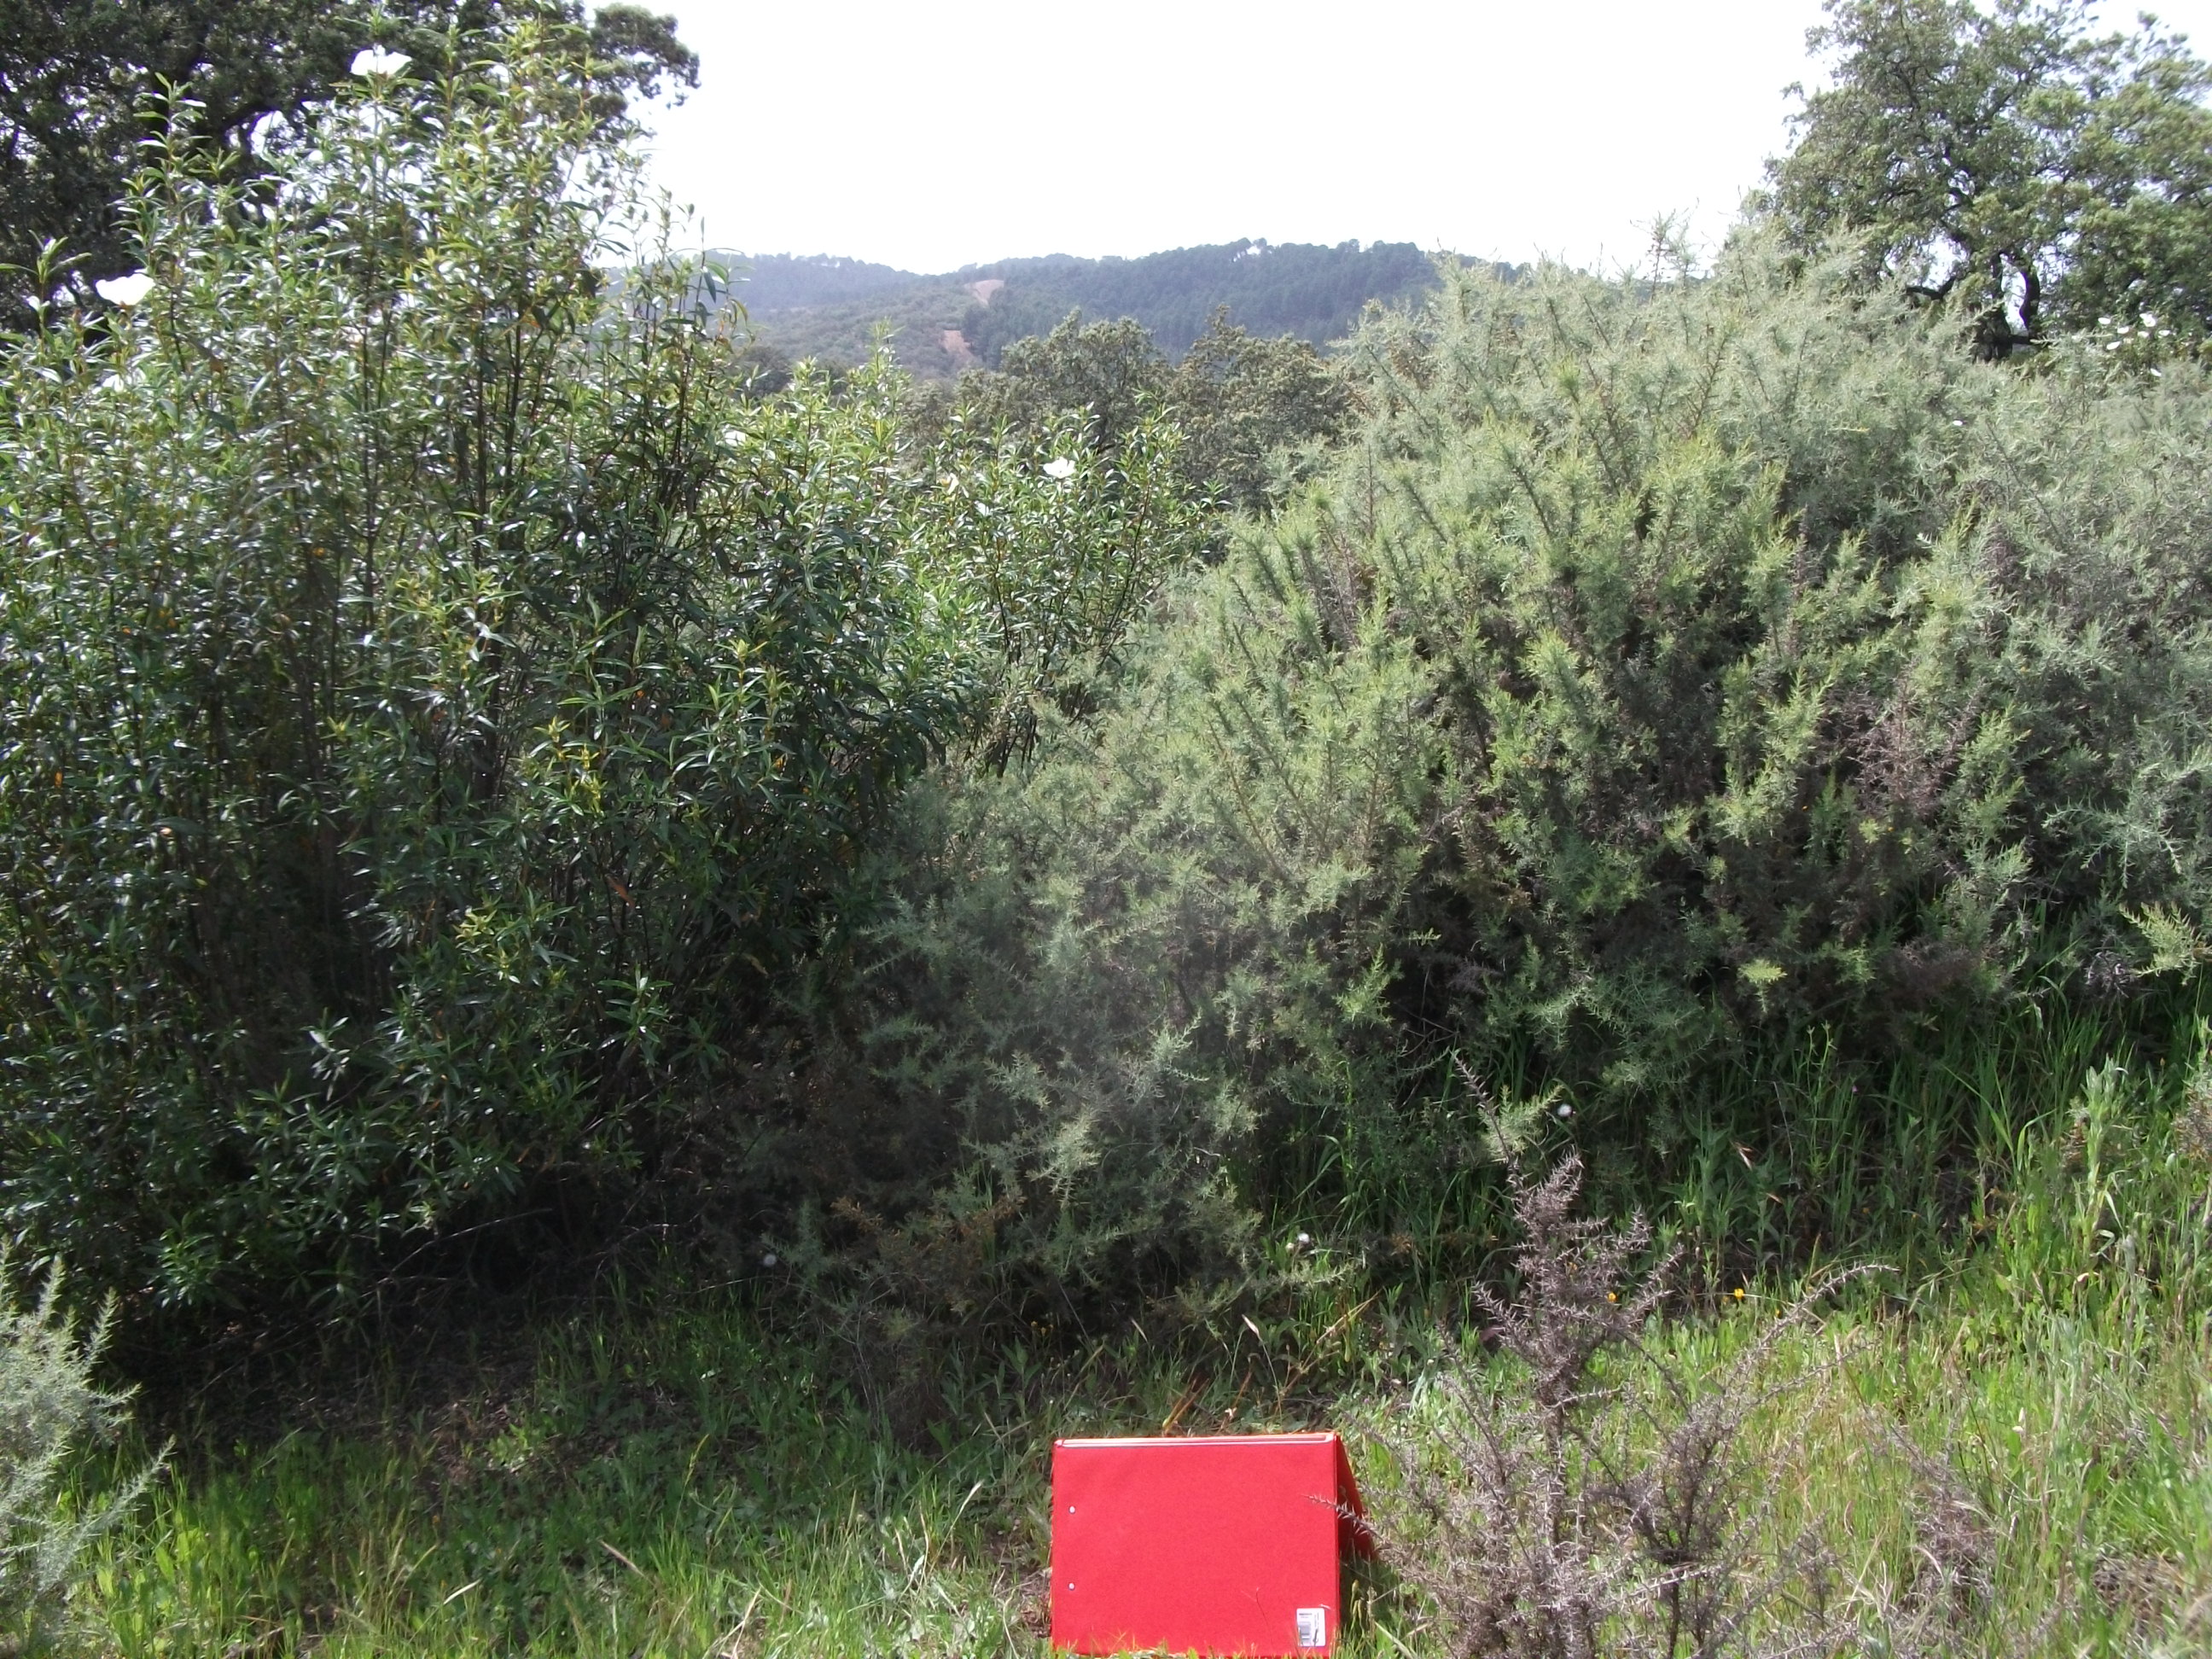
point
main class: Shrubland
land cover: Shrubland with sparse tree cover
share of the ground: > 75 %
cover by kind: shrubs 80 %, herbaceous plants 15 %, broadleaved forest trees 5 %
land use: Agriculture (excluding fallow land and kitchen gardens)
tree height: > 5 m
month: April
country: ES
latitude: 37.8265
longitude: -6.7119
